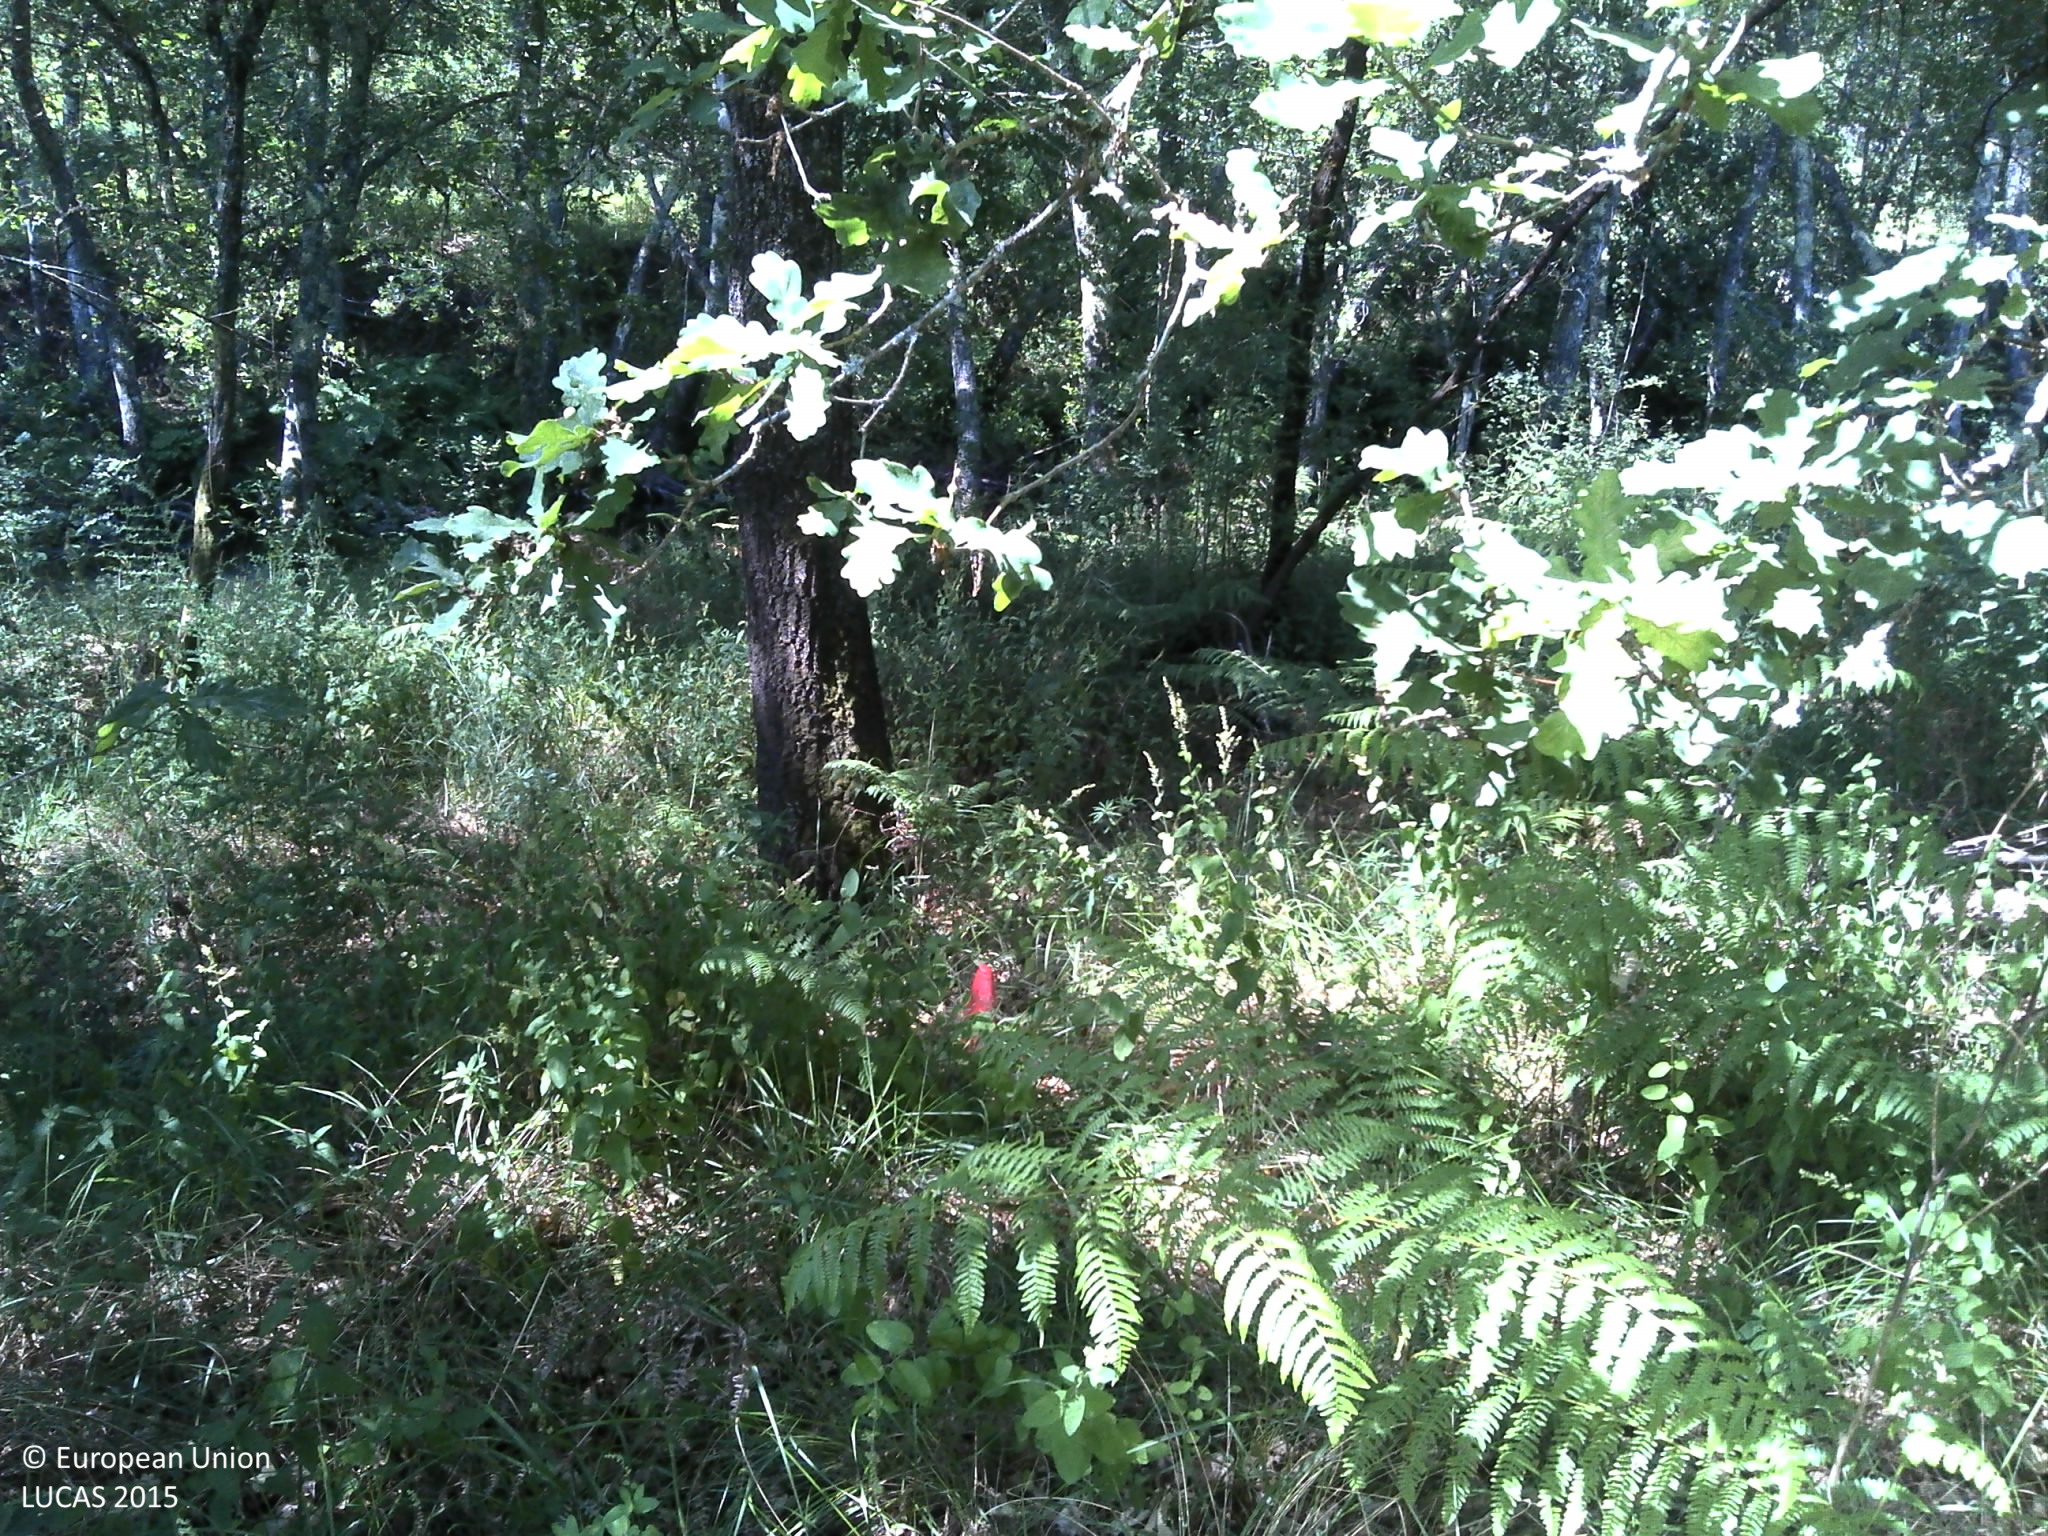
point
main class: Woodland
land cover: Broadleaved woodland
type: thermophilous deciduous forest
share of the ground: 10 - 25 %
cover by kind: shrubs 40 %, broadleaved forest trees 20 %, herbaceous plants 20 %, unconsolidated bare surface 20 %
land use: Forestry
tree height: > 5 m
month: July
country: PT
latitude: 40.7566
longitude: -7.8566
